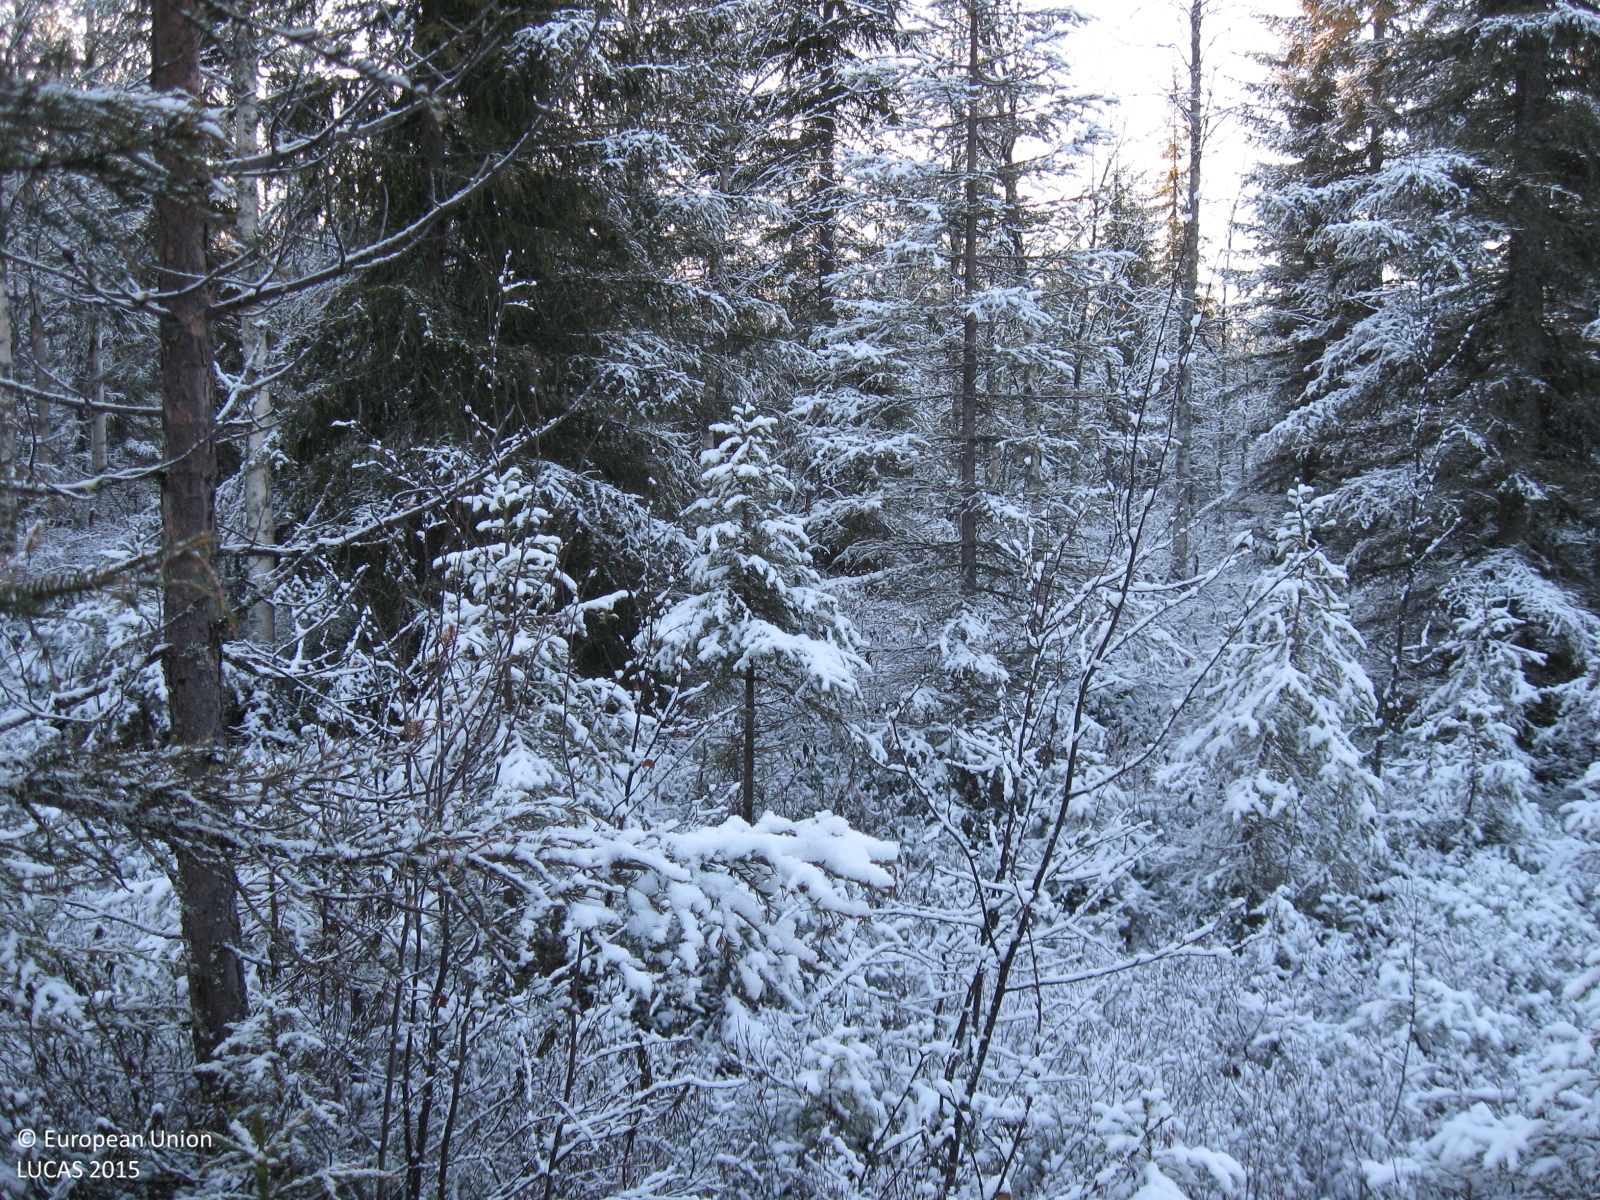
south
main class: Woodland
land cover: Spruce dominated mixed woodland
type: boreal forest
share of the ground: 50 - 75 %
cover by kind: coniferous forest trees 35 %, broadleaved forest trees 25 %, shrubs 20 %, herbaceous plants 10 %, lichens and mosses 10 %
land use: Forestry
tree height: > 5 m
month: October
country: SE
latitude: 66.3430
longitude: 21.4659
